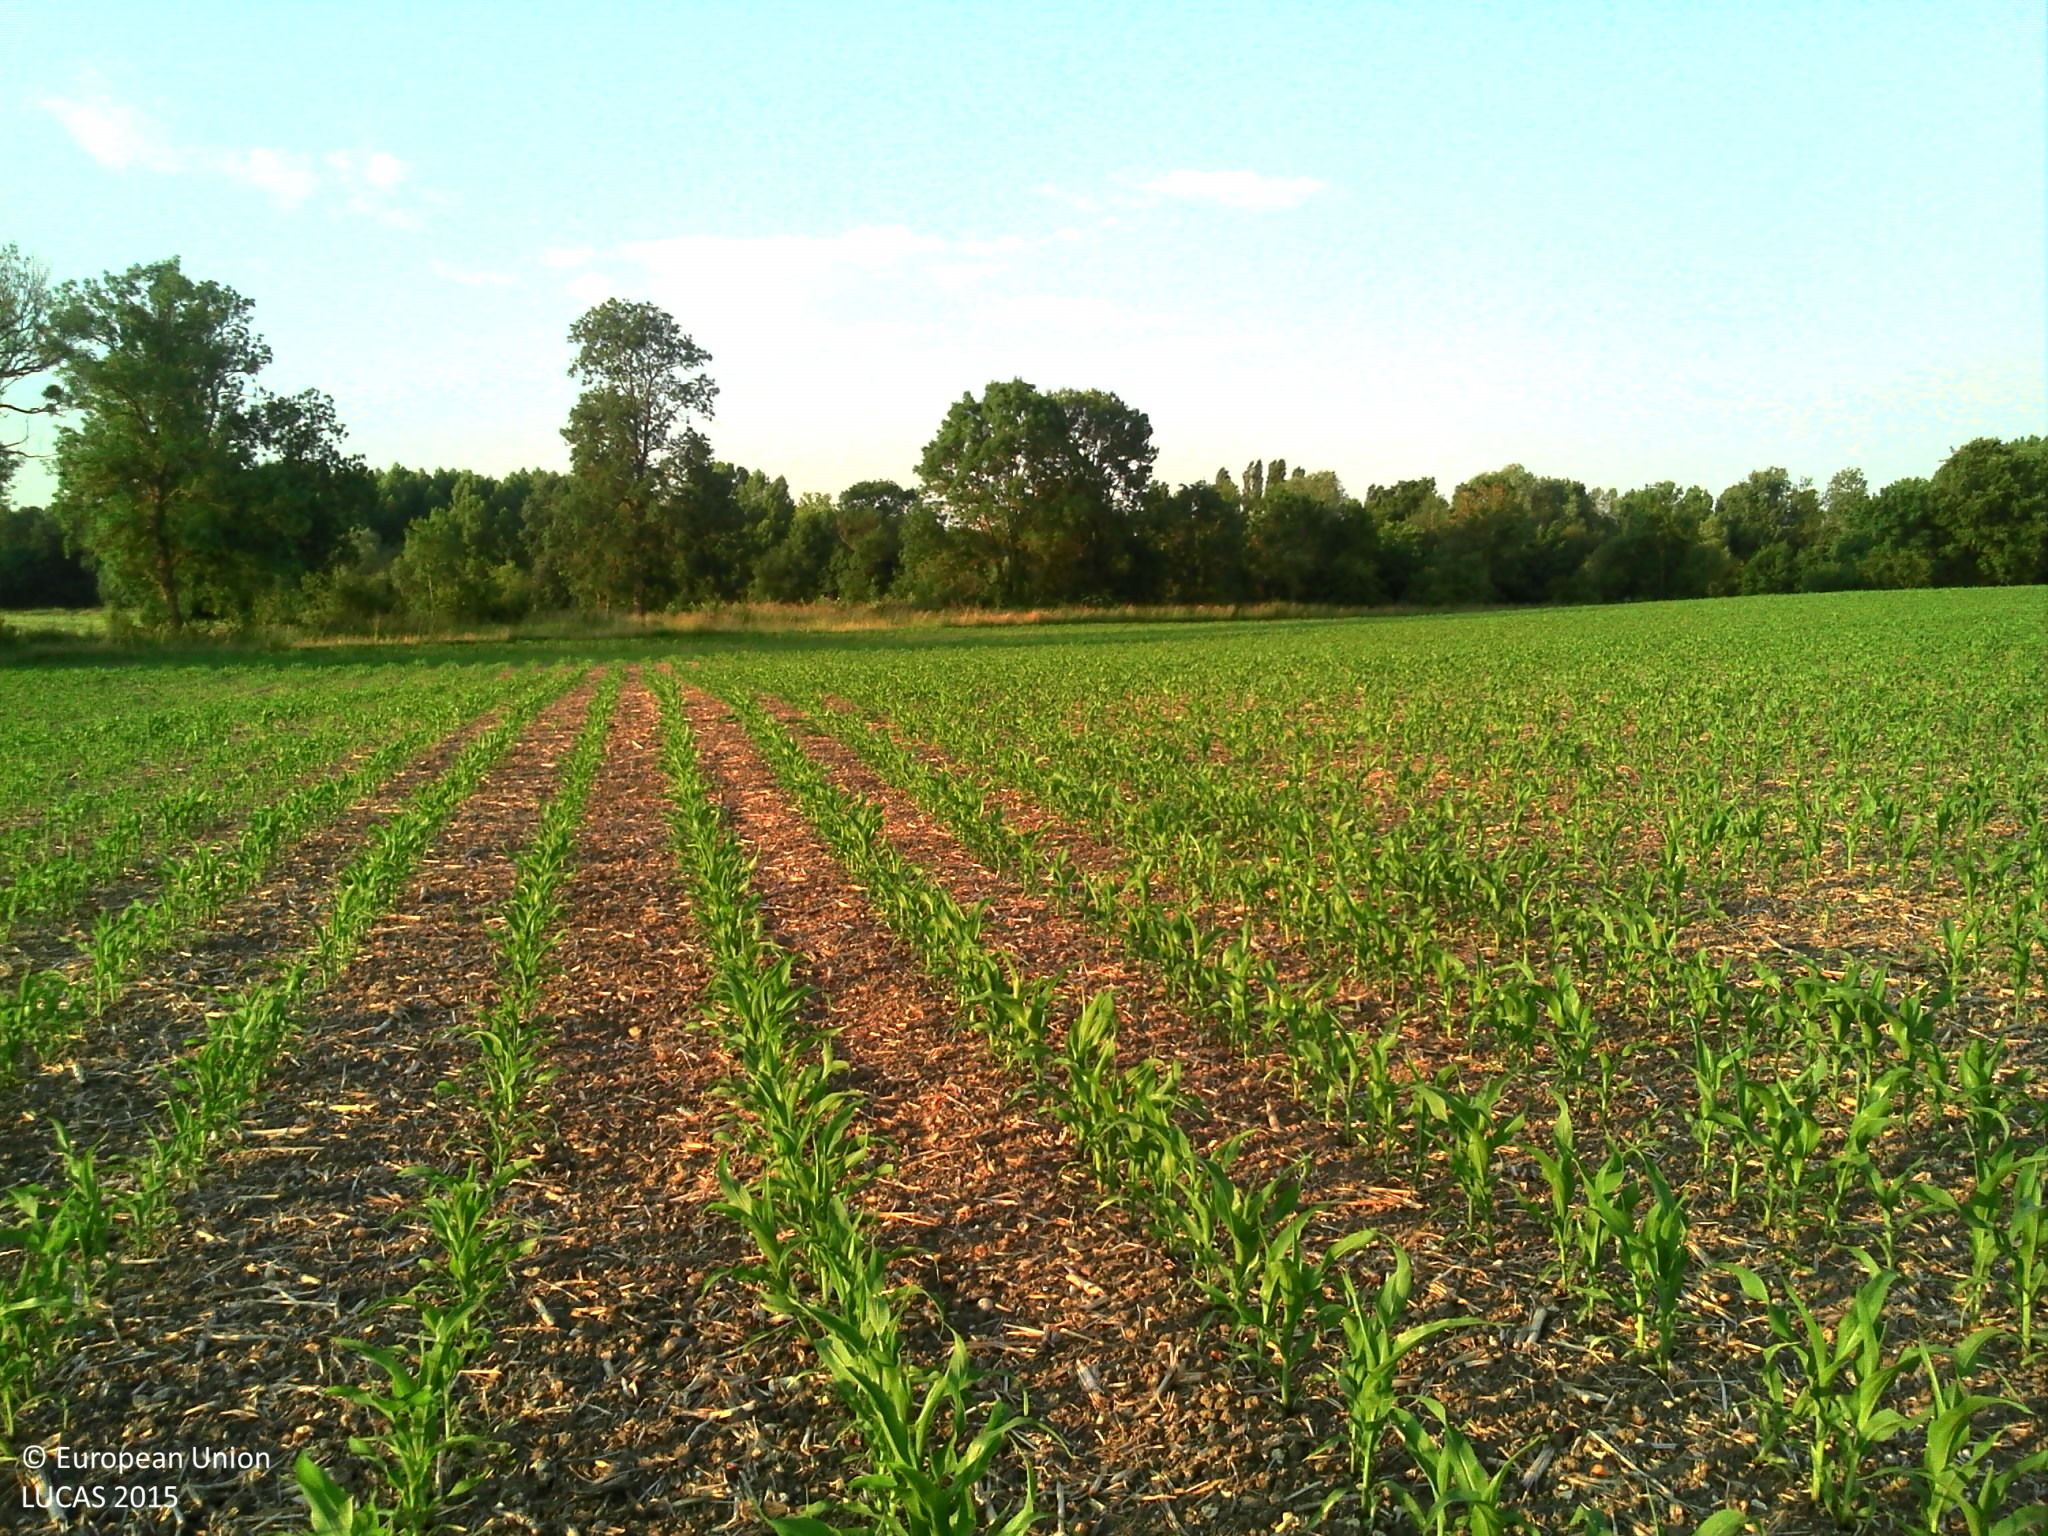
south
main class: Cropland
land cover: Maize
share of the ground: 25 - 50 %
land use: Agriculture (excluding fallow land and kitchen gardens)
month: June
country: FR
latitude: 46.7852
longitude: 0.5639
